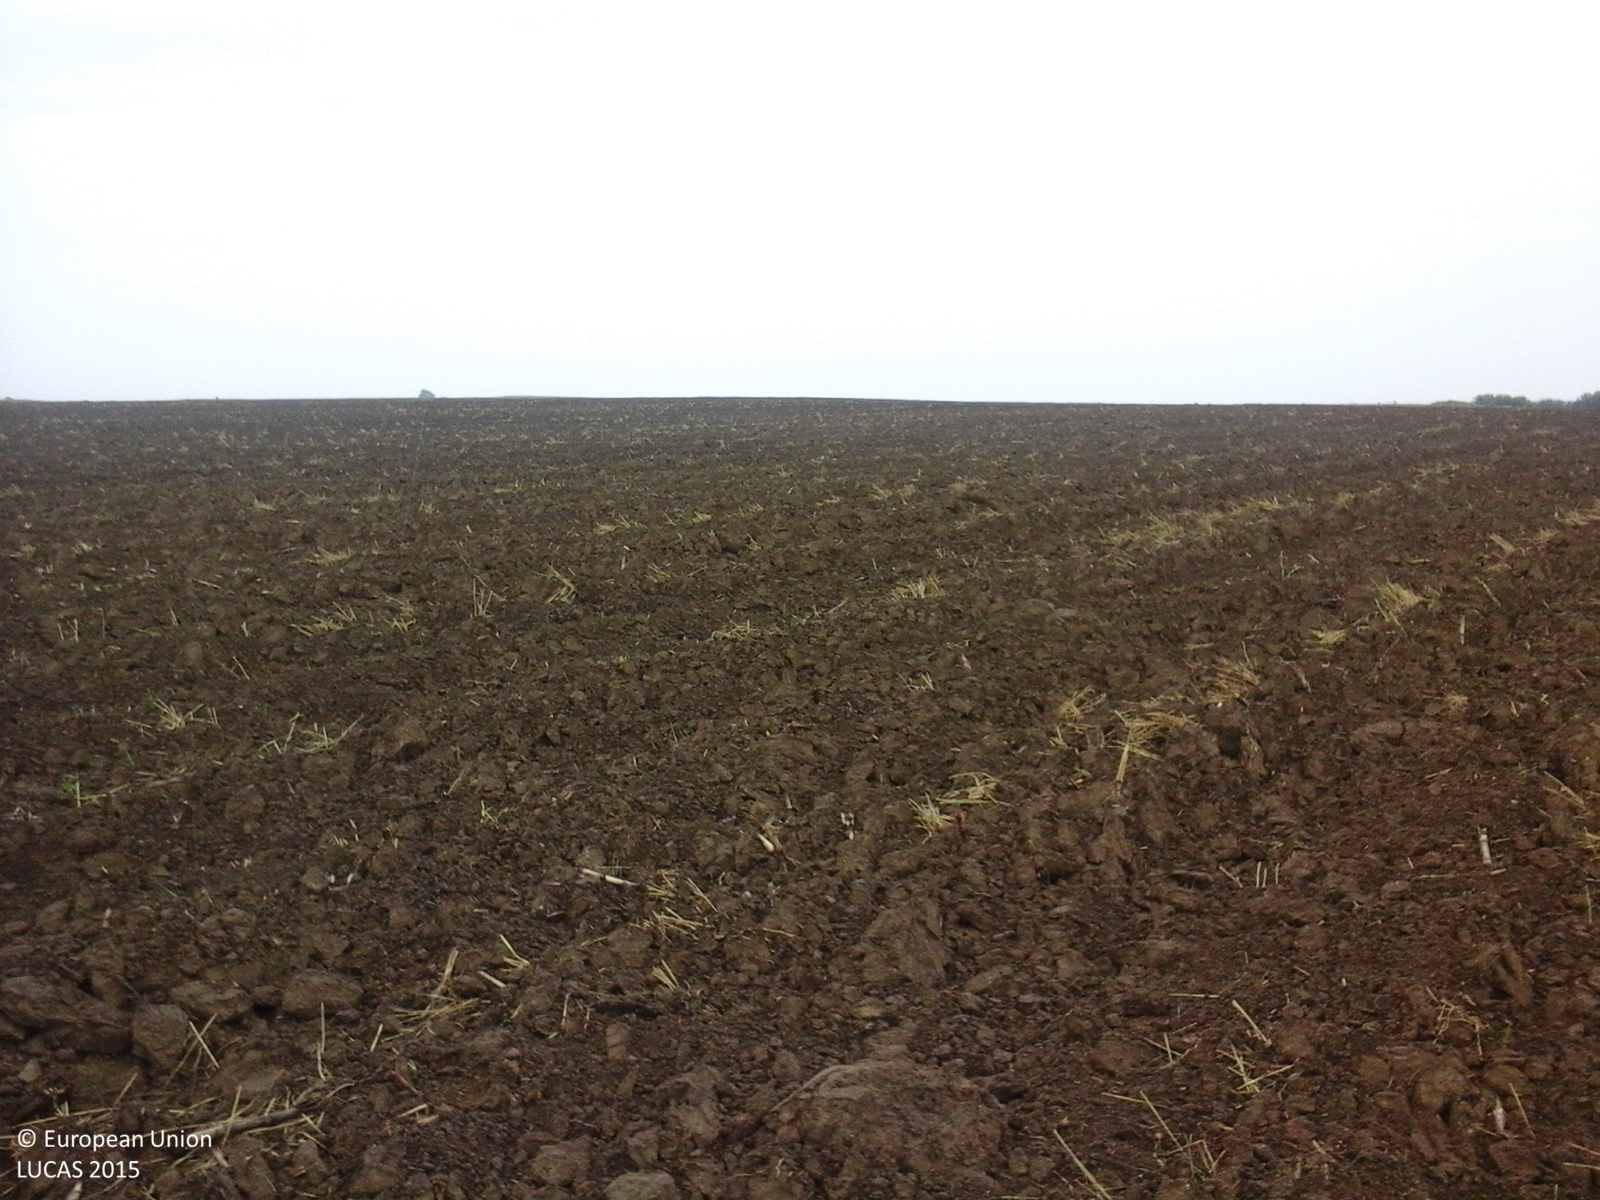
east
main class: Cropland
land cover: Common wheat
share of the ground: < 10 %
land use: Agriculture (excluding fallow land and kitchen gardens)
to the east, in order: Common wheat
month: September
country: RO
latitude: 47.6216
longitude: 22.3094
